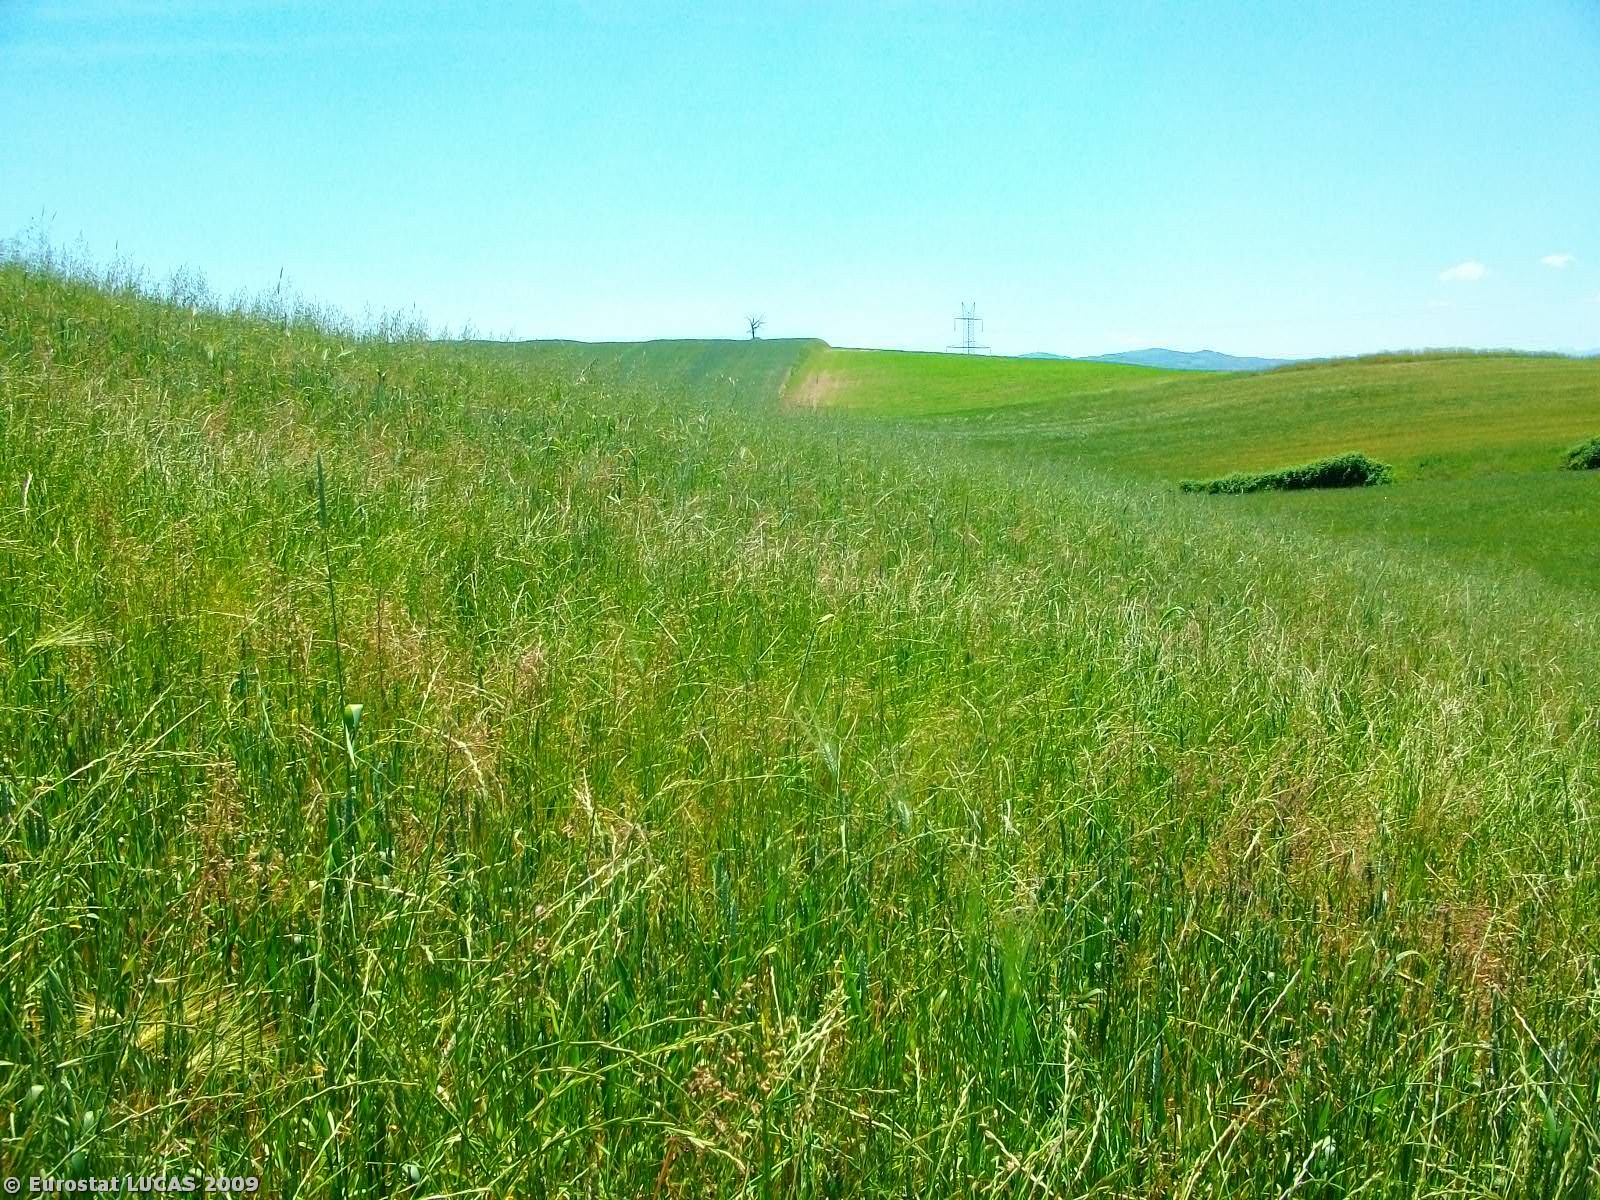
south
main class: Cropland
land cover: Common wheat
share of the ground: > 75 %
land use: Agriculture (excluding fallow land and kitchen gardens)
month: May
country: GR
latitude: 39.8613
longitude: 21.6640
